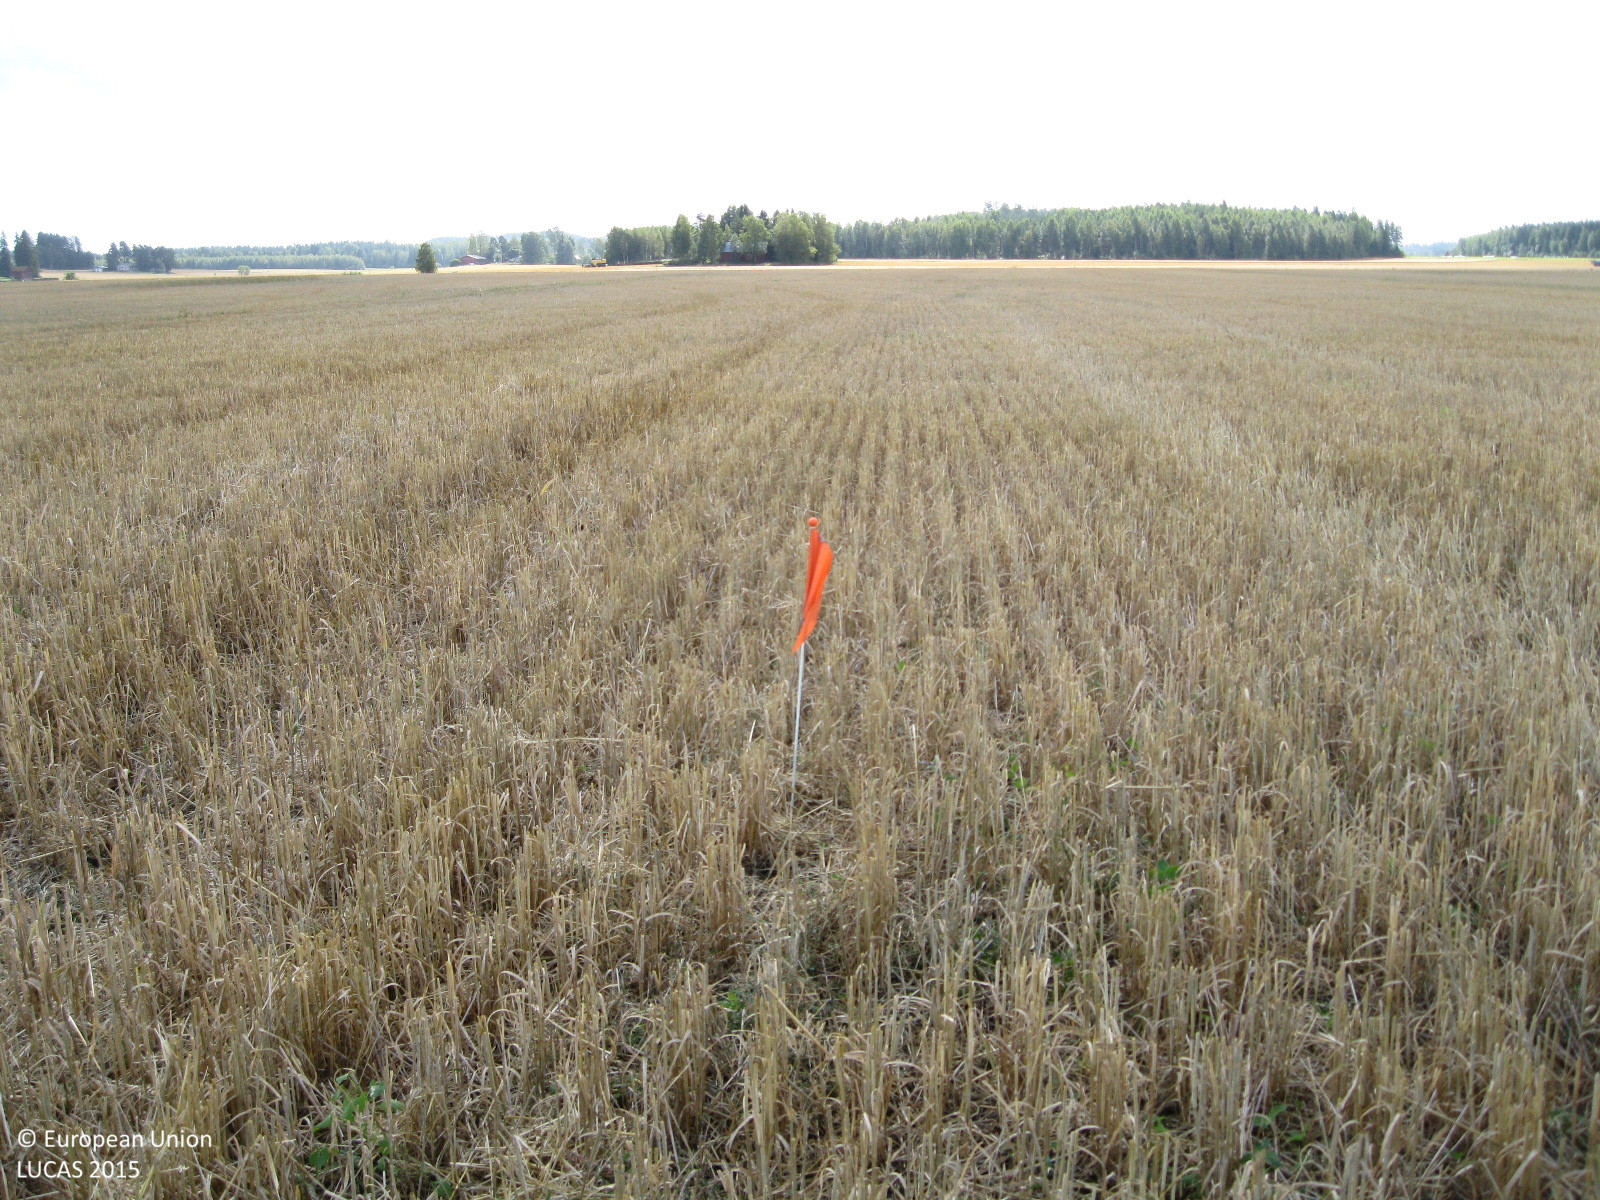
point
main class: Cropland
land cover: Common wheat
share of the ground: > 75 %
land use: Agriculture (excluding fallow land and kitchen gardens)
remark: Harvested field
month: September
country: FI
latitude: 60.8324
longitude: 24.9202
